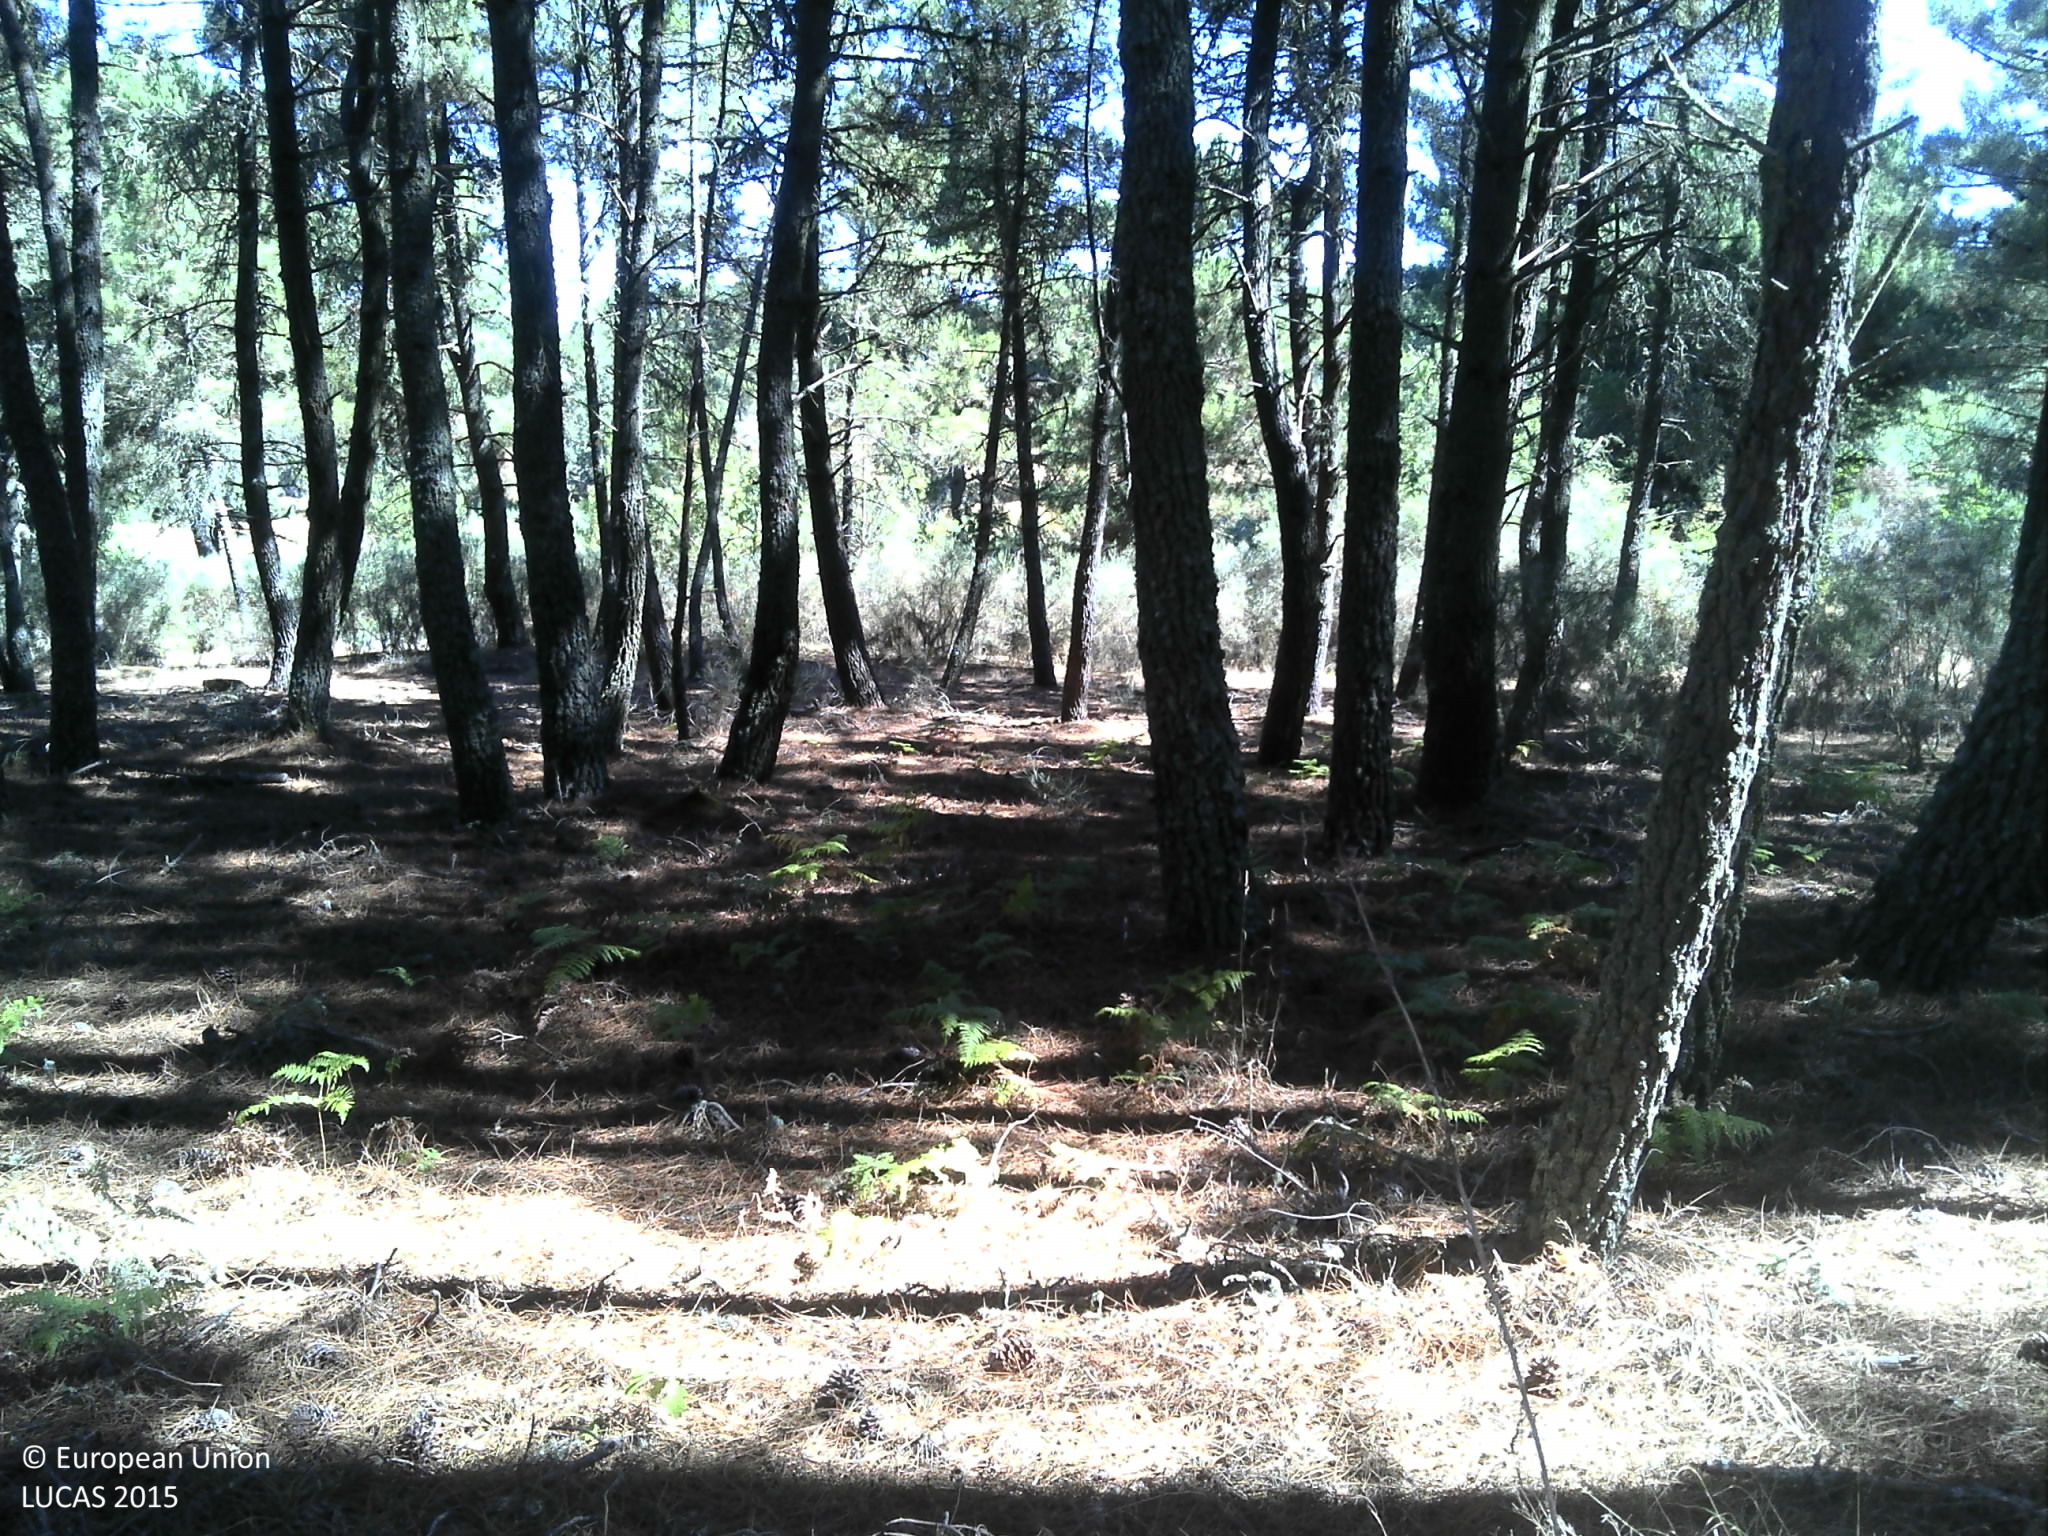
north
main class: Woodland
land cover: Pine dominated coniferous woodland
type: coniferous forest of the mediterranean region
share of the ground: < 10 %
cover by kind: unconsolidated bare surface 75 %, coniferous forest trees 20 %, shrubs 5 %
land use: Forestry
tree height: > 5 m
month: July
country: PT
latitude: 41.2285
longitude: -7.2844
